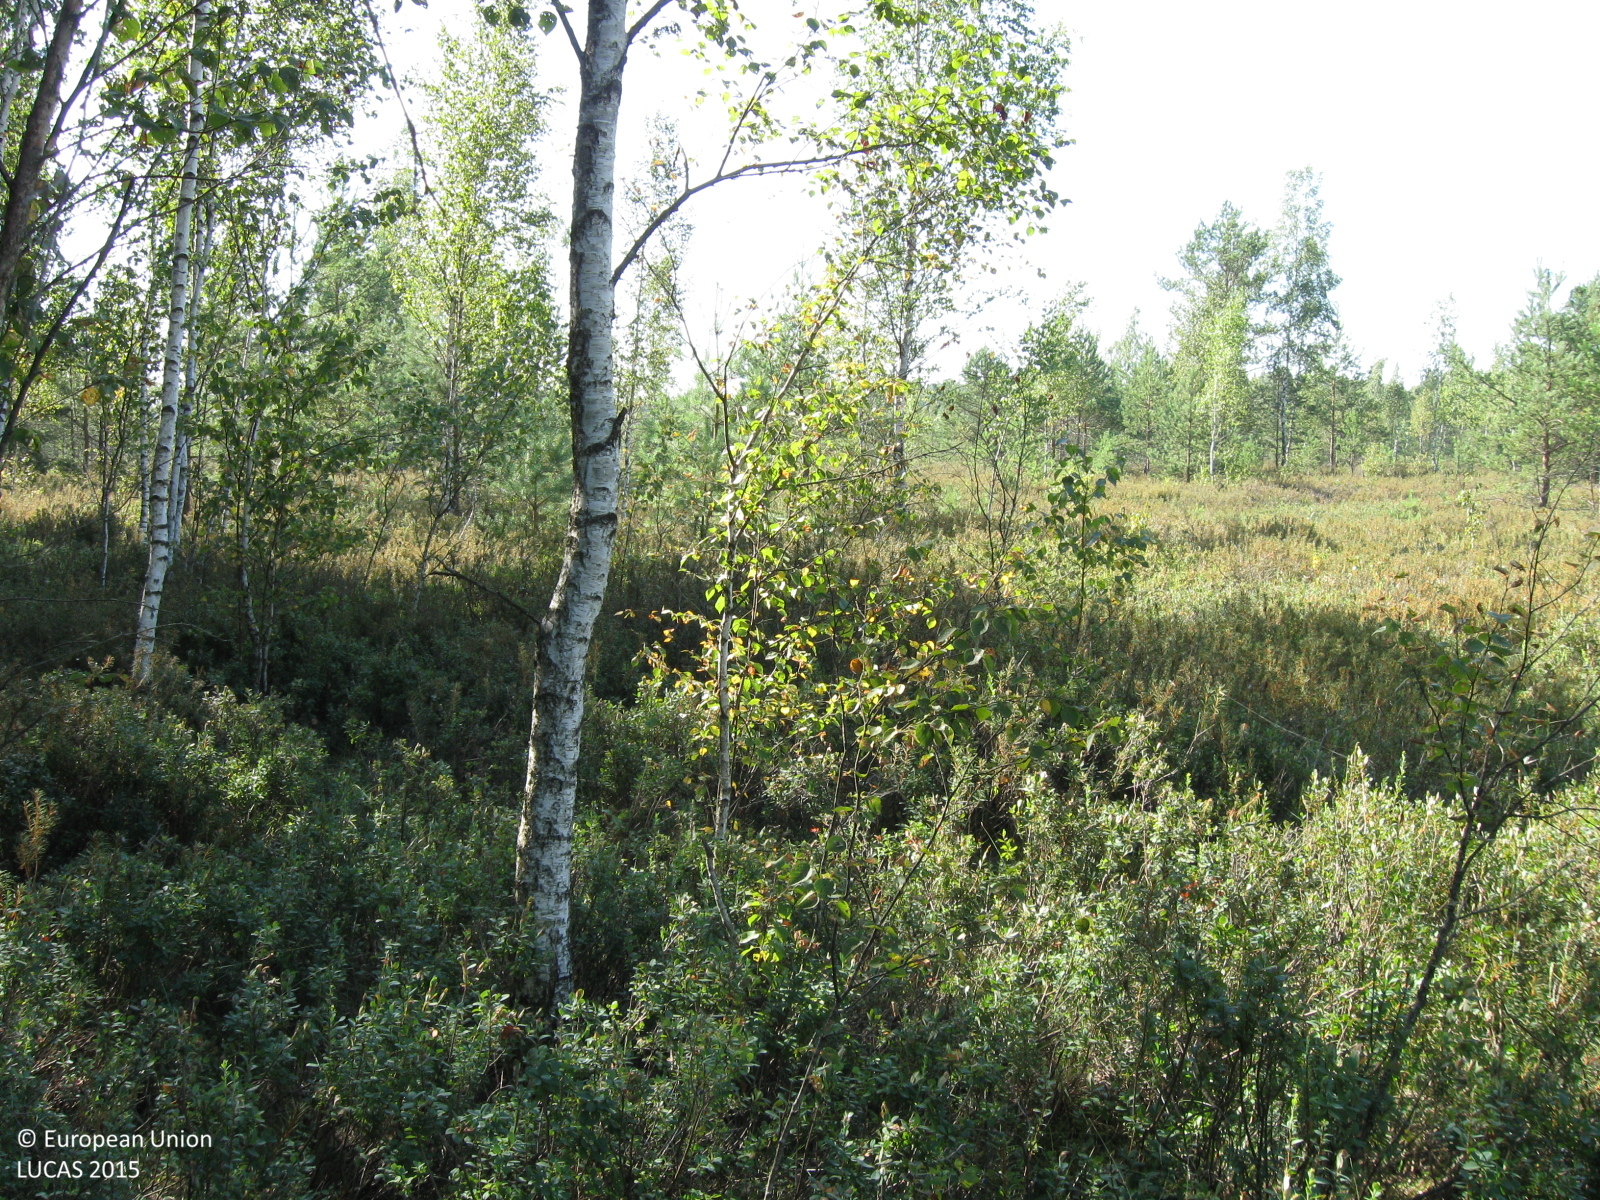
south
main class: Woodland
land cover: Pine dominated mixed woodland
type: mire and swamp forests
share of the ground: 50 - 75 %
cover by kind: broadleaved forest trees 35 %, shrubs 35 %, coniferous forest trees 15 %, herbaceous plants 10 %, lichens and mosses 5 %
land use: Forestry
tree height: > 5 m
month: August
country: LT
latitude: 55.1288
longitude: 22.7543
